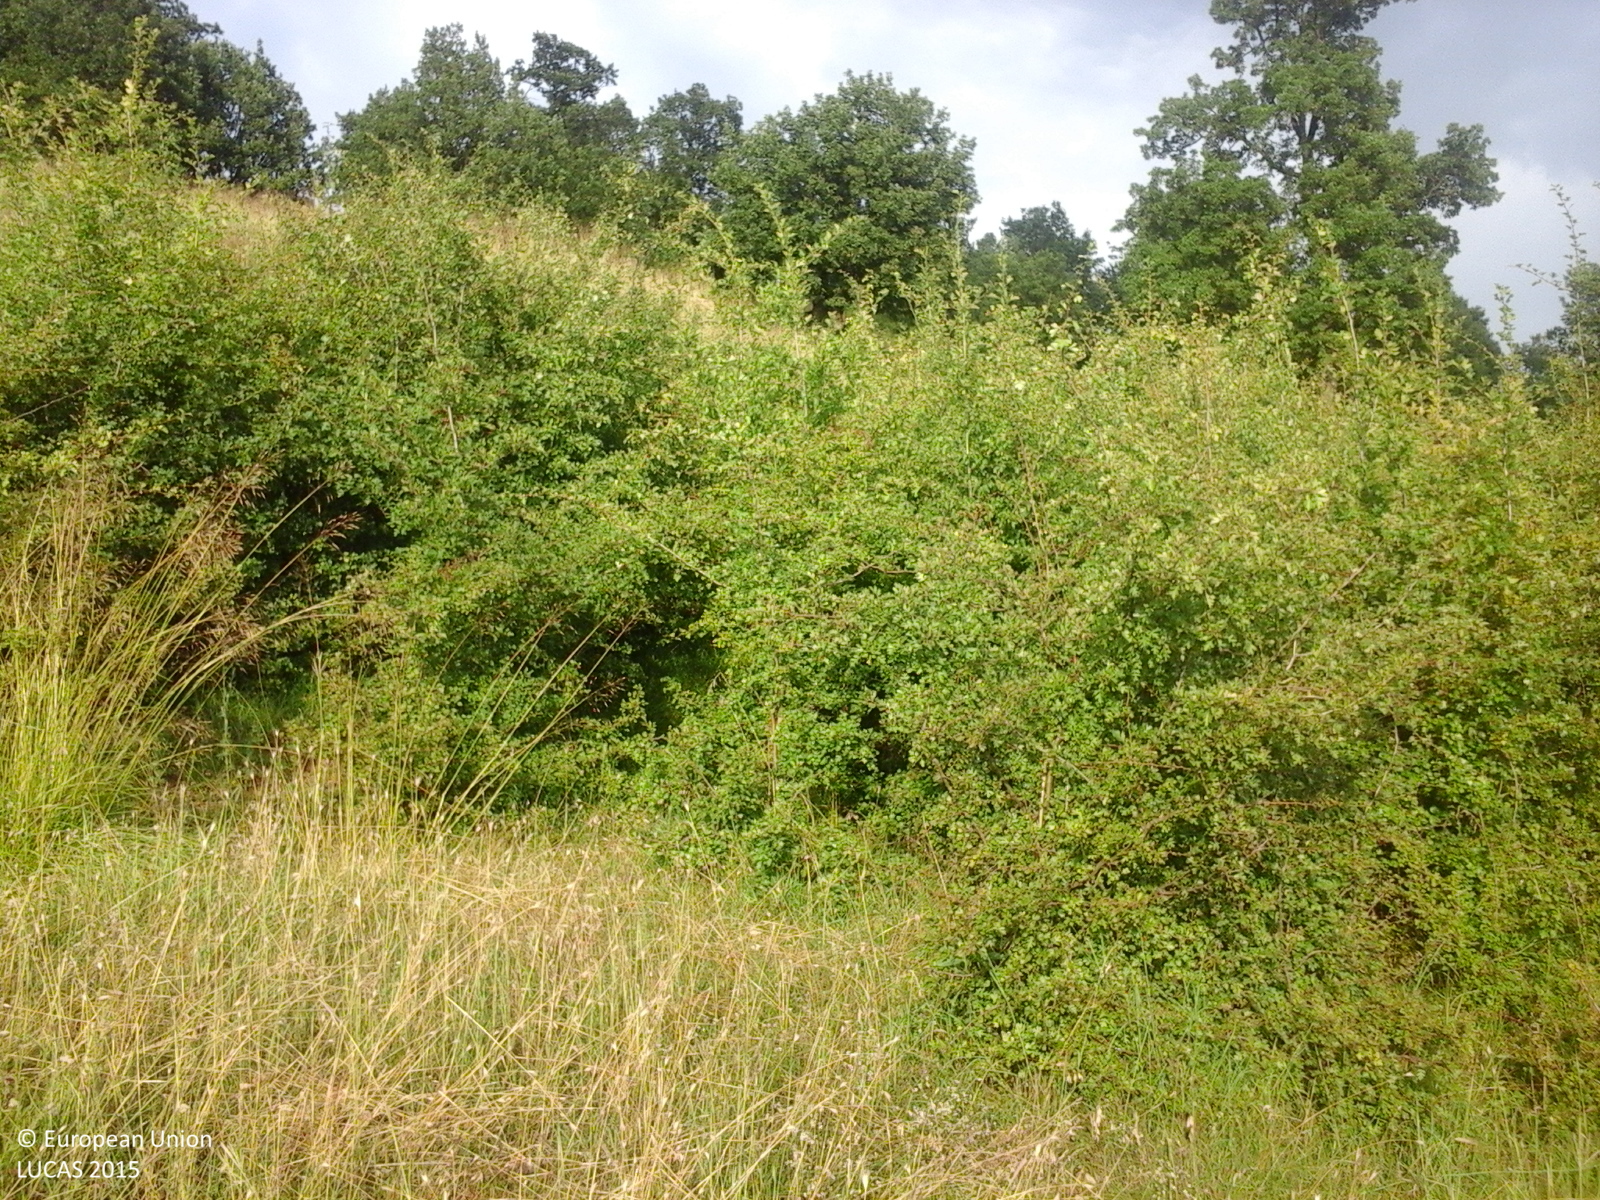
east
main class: Grassland
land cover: Grassland with sparse tree/shrub cover
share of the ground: > 75 %
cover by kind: herbaceous plants 85 %, shrubs 10 %, broadleaved forest trees 5 %
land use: Agriculture (excluding fallow land and kitchen gardens)
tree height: < 5 m
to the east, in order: Grassland with sparse tree/shrub cover; Broadleaved woodland; Other bare soil
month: July
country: RO
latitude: 44.1166
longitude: 24.6016
